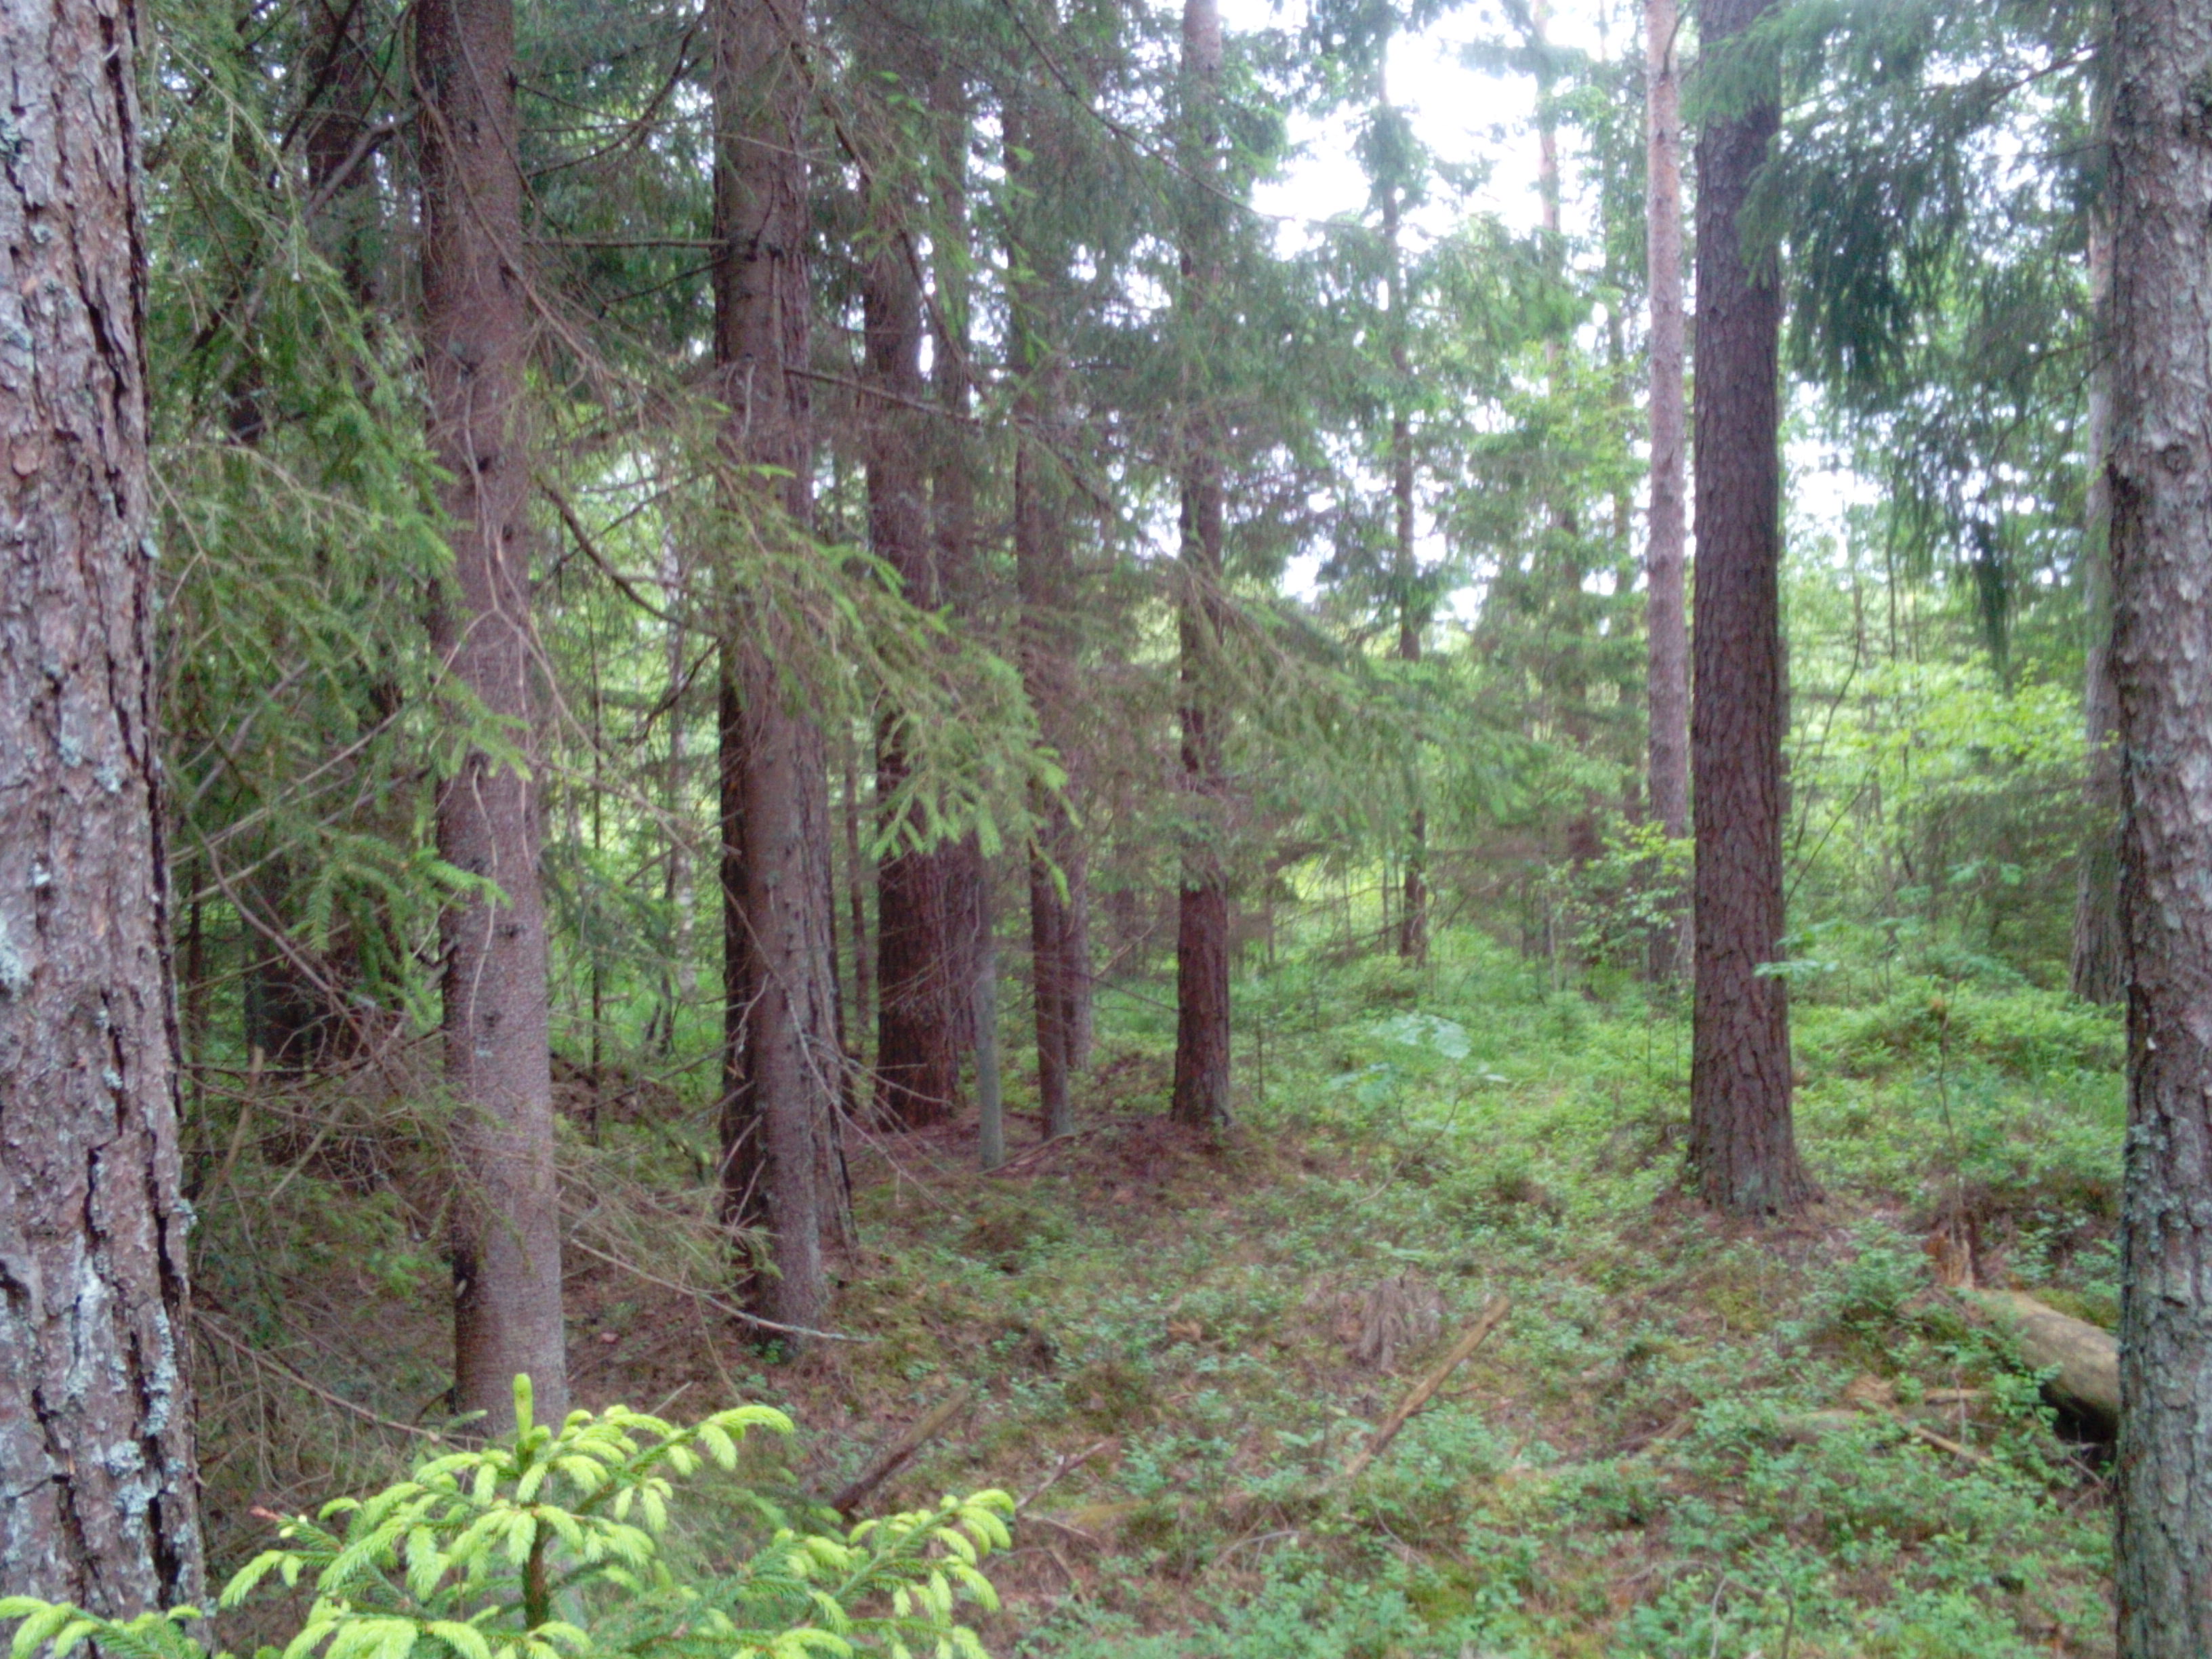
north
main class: Woodland
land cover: Other coniferous woodland
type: hemiboreal forest and nemoral coniferous forest and mixed broadleaved-coniferous forest
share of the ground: > 75 %
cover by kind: coniferous forest trees 80 %, herbaceous plants 10 %, lichens and mosses 10 %
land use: Forestry
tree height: > 5 m
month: June
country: LV
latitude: 56.9420
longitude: 21.4971
